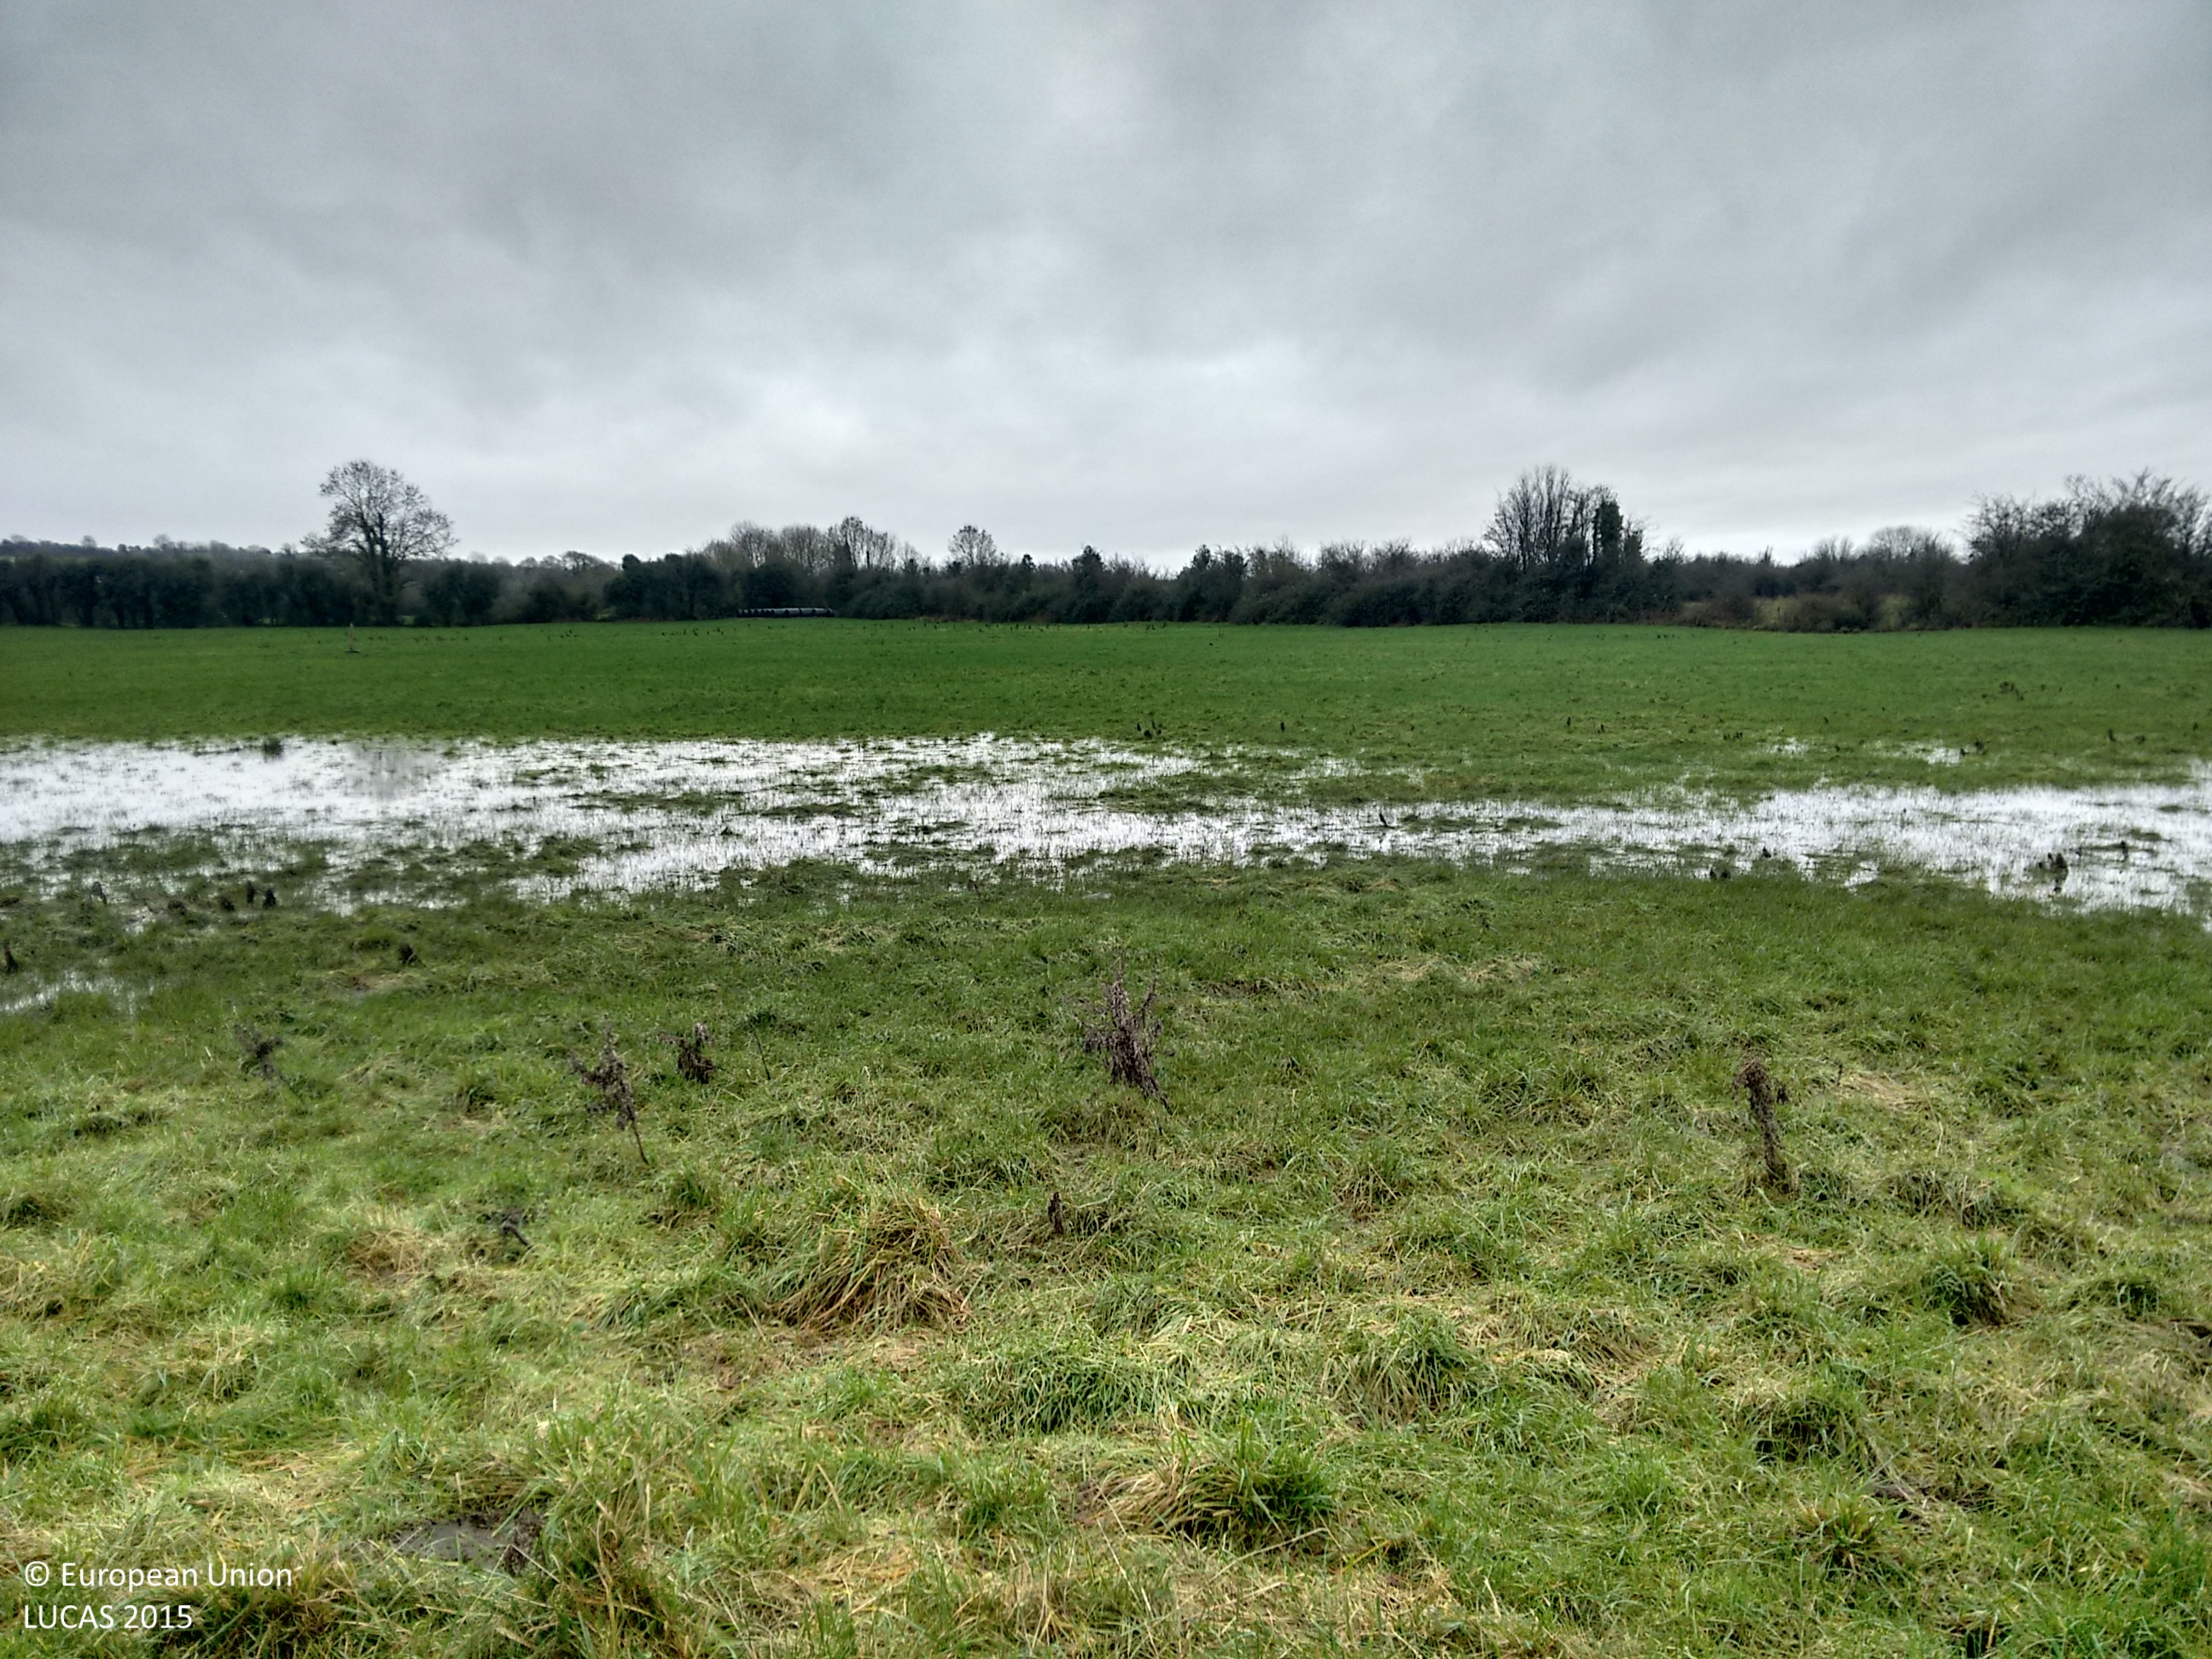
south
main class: Grassland
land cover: Grassland without tree/shrub cover
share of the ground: 50 - 75 %
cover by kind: herbaceous plants 95 %
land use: Agriculture (excluding fallow land and kitchen gardens)
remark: Temporary flooded
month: December
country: IE
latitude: 53.3114
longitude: -7.8662
